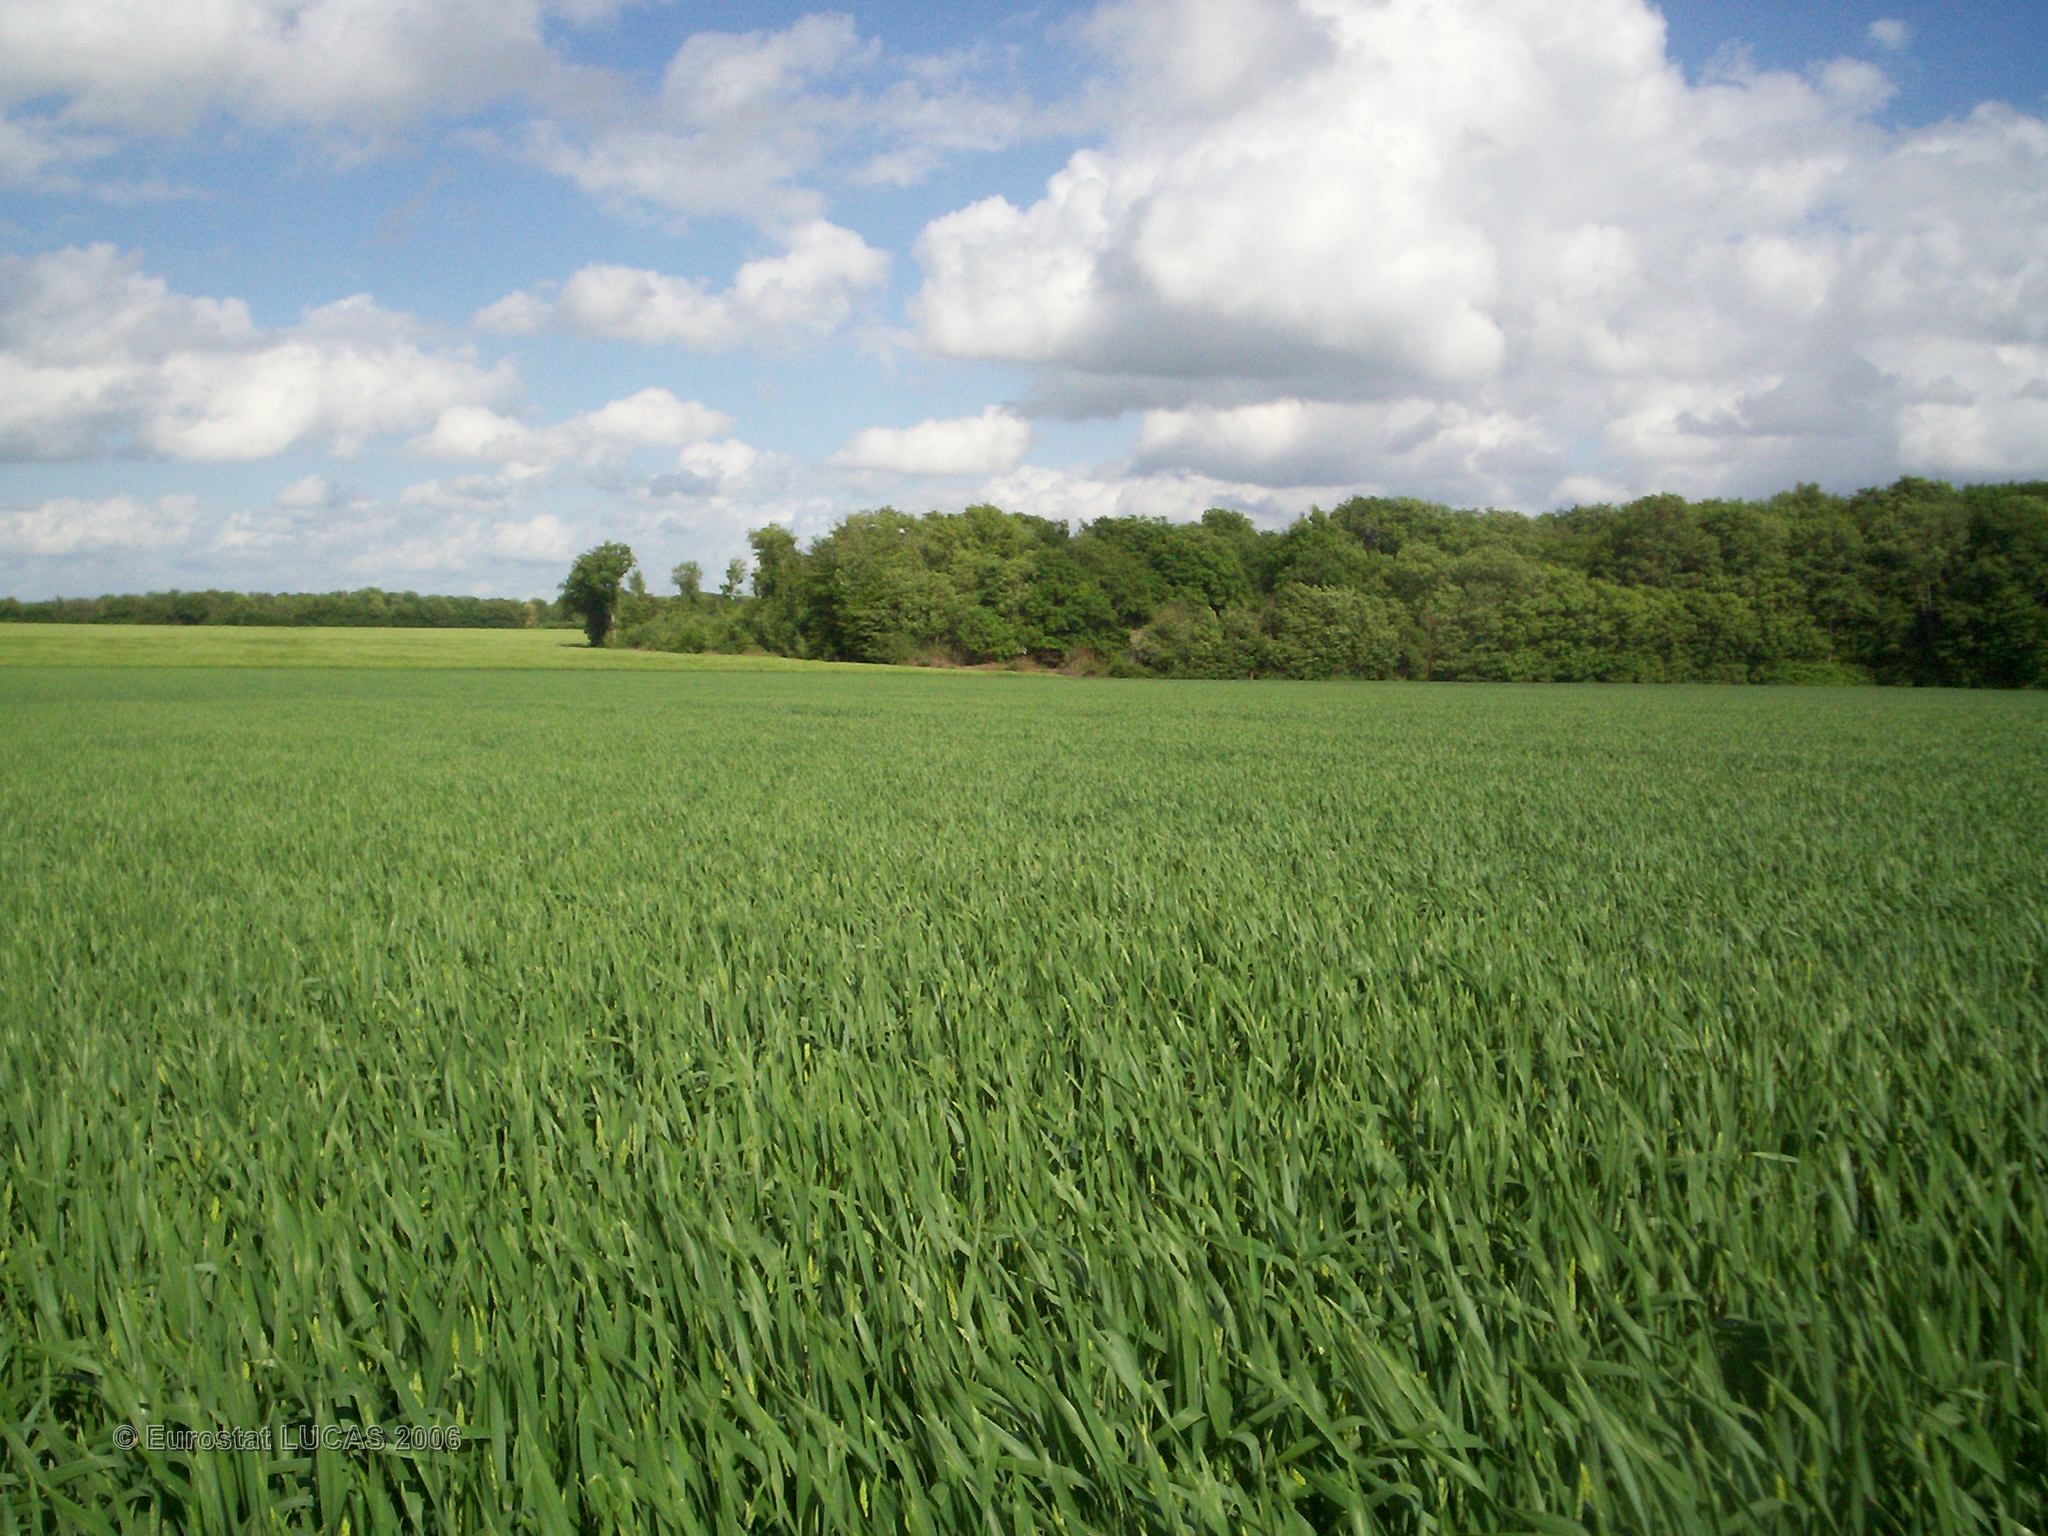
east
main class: Cropland
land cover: Common wheat
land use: Agriculture (excluding fallow land and kitchen gardens)
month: May
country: FR
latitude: 47.7603
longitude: 2.9090
